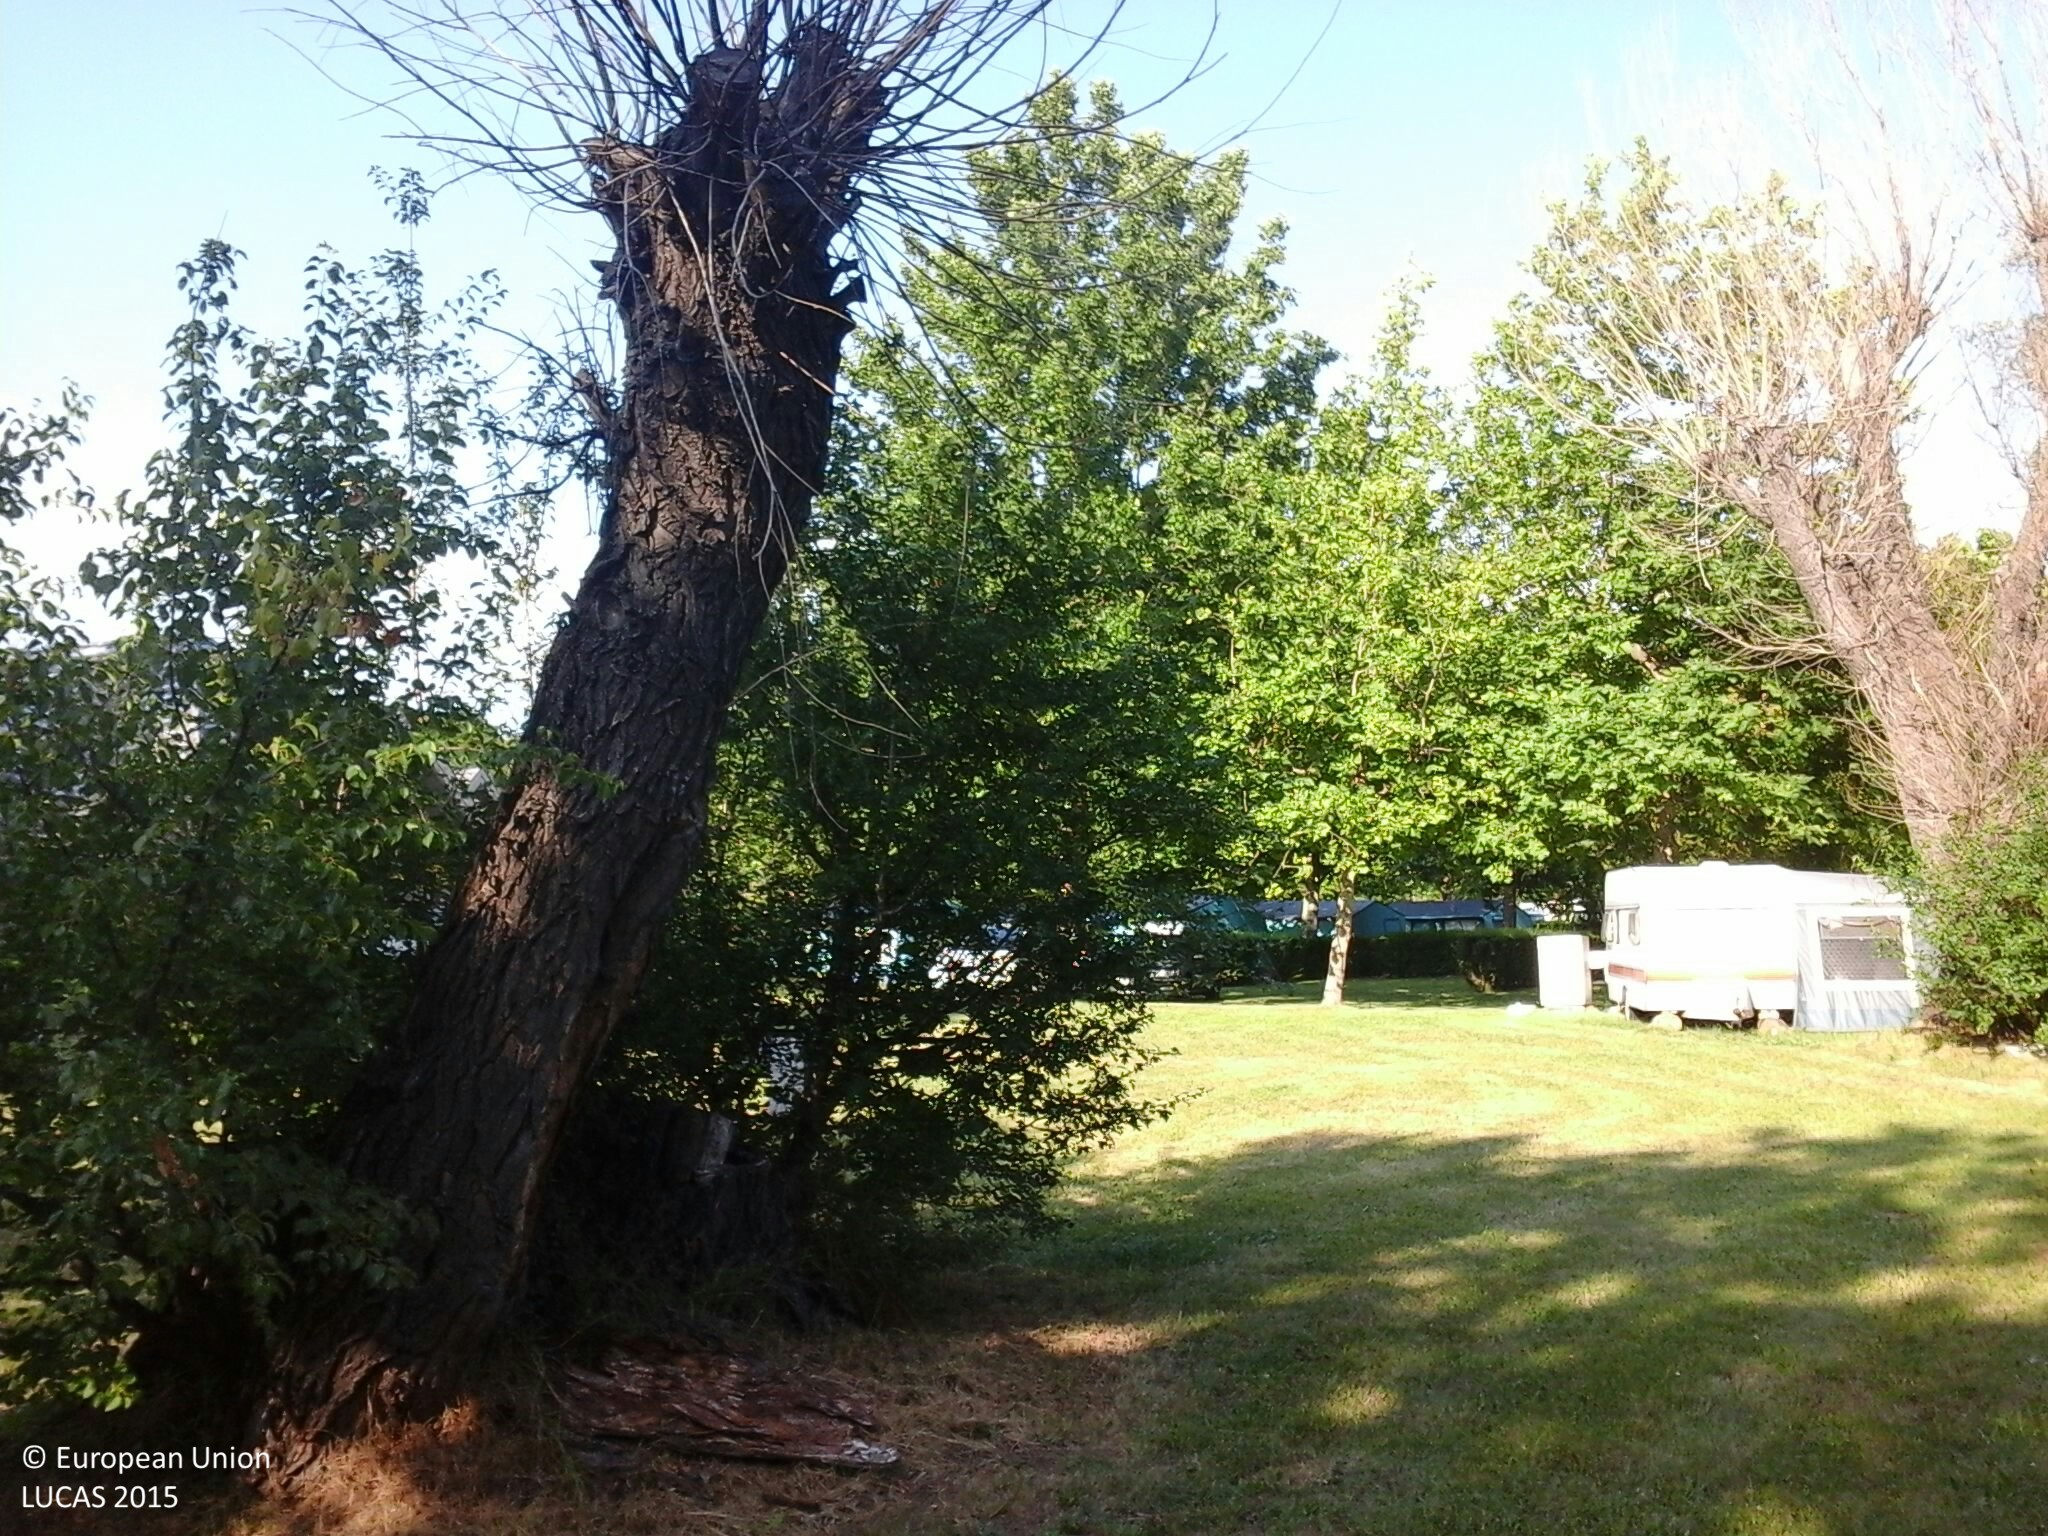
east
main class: Grassland
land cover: Grassland with sparse tree/shrub cover
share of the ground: > 75 %
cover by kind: herbaceous plants 90 %, broadleaved forest trees 5 %, shrubs 5 %
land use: Commerce
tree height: < 5 m
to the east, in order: Grassland with sparse tree/shrub cover; Artificial constructions in urban areas
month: July
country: HU
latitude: 46.8828
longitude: 17.7629
